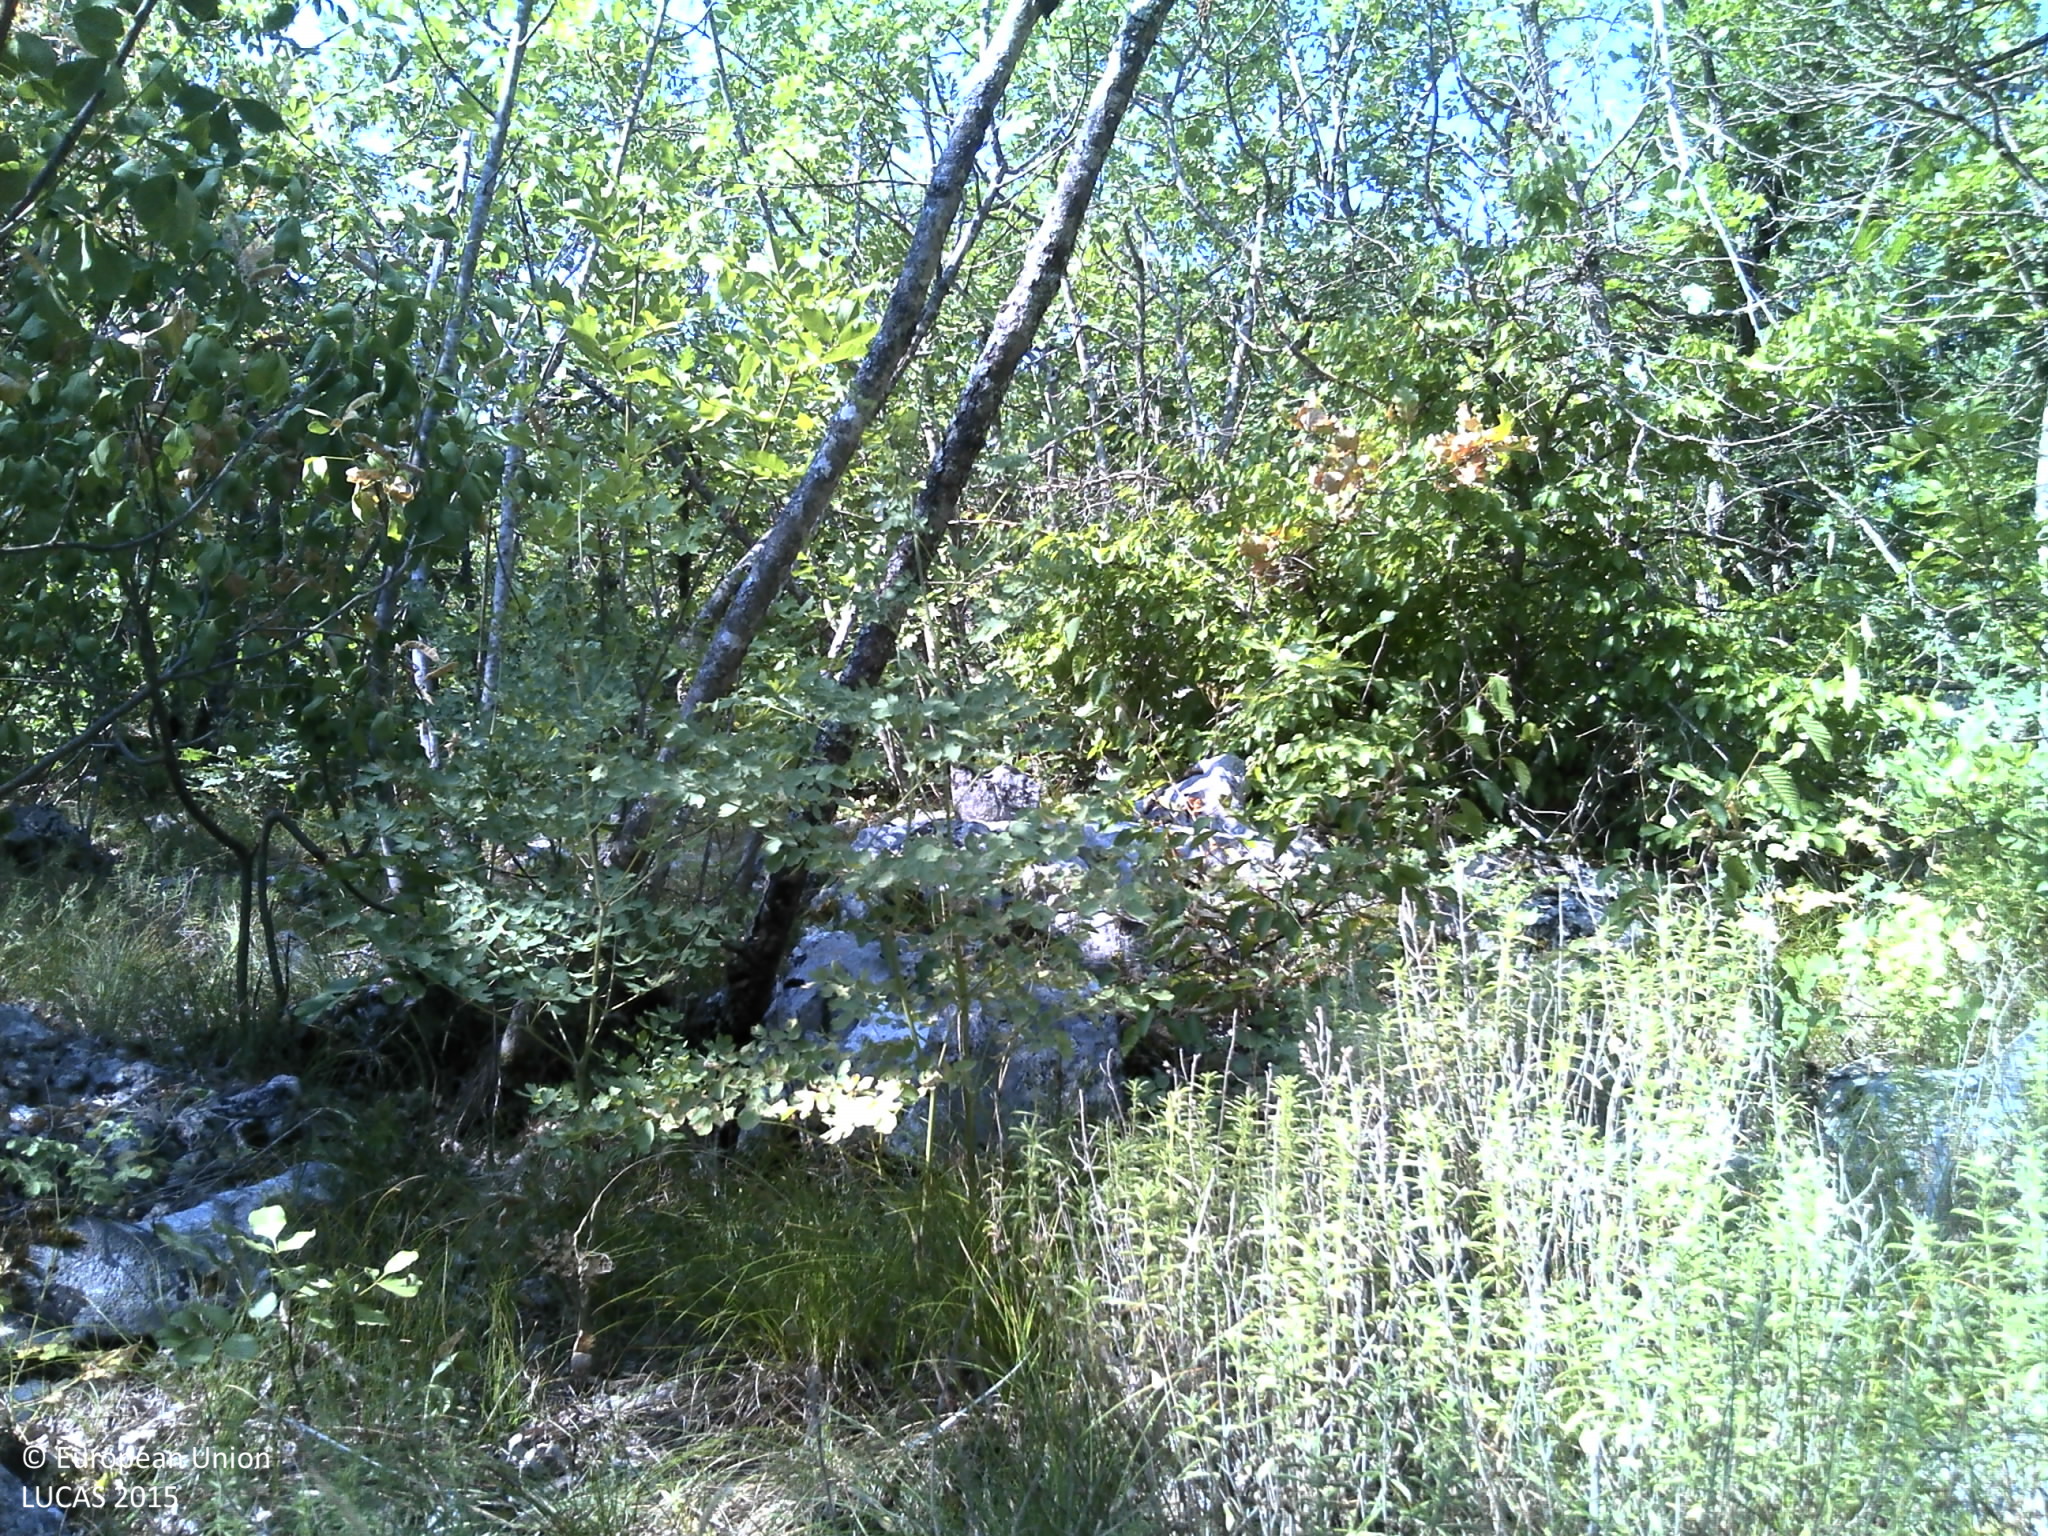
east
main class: Woodland
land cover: Broadleaved woodland
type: thermophilous deciduous forest
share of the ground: 50 - 75 %
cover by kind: broadleaved forest trees 65 %, shrubs 15 %, herbaceous plants 15 %, consolidated bare surface 5 %
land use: Semi-natural and natural areas not in use
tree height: > 5 m
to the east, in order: Broadleaved woodland; Shrubland with sparse tree cover; Dry stone walls; Broadleaved woodland; Shrubland with sparse tree cover; Broadleaved woodland
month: July
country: HR
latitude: 43.4017
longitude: 17.0912
